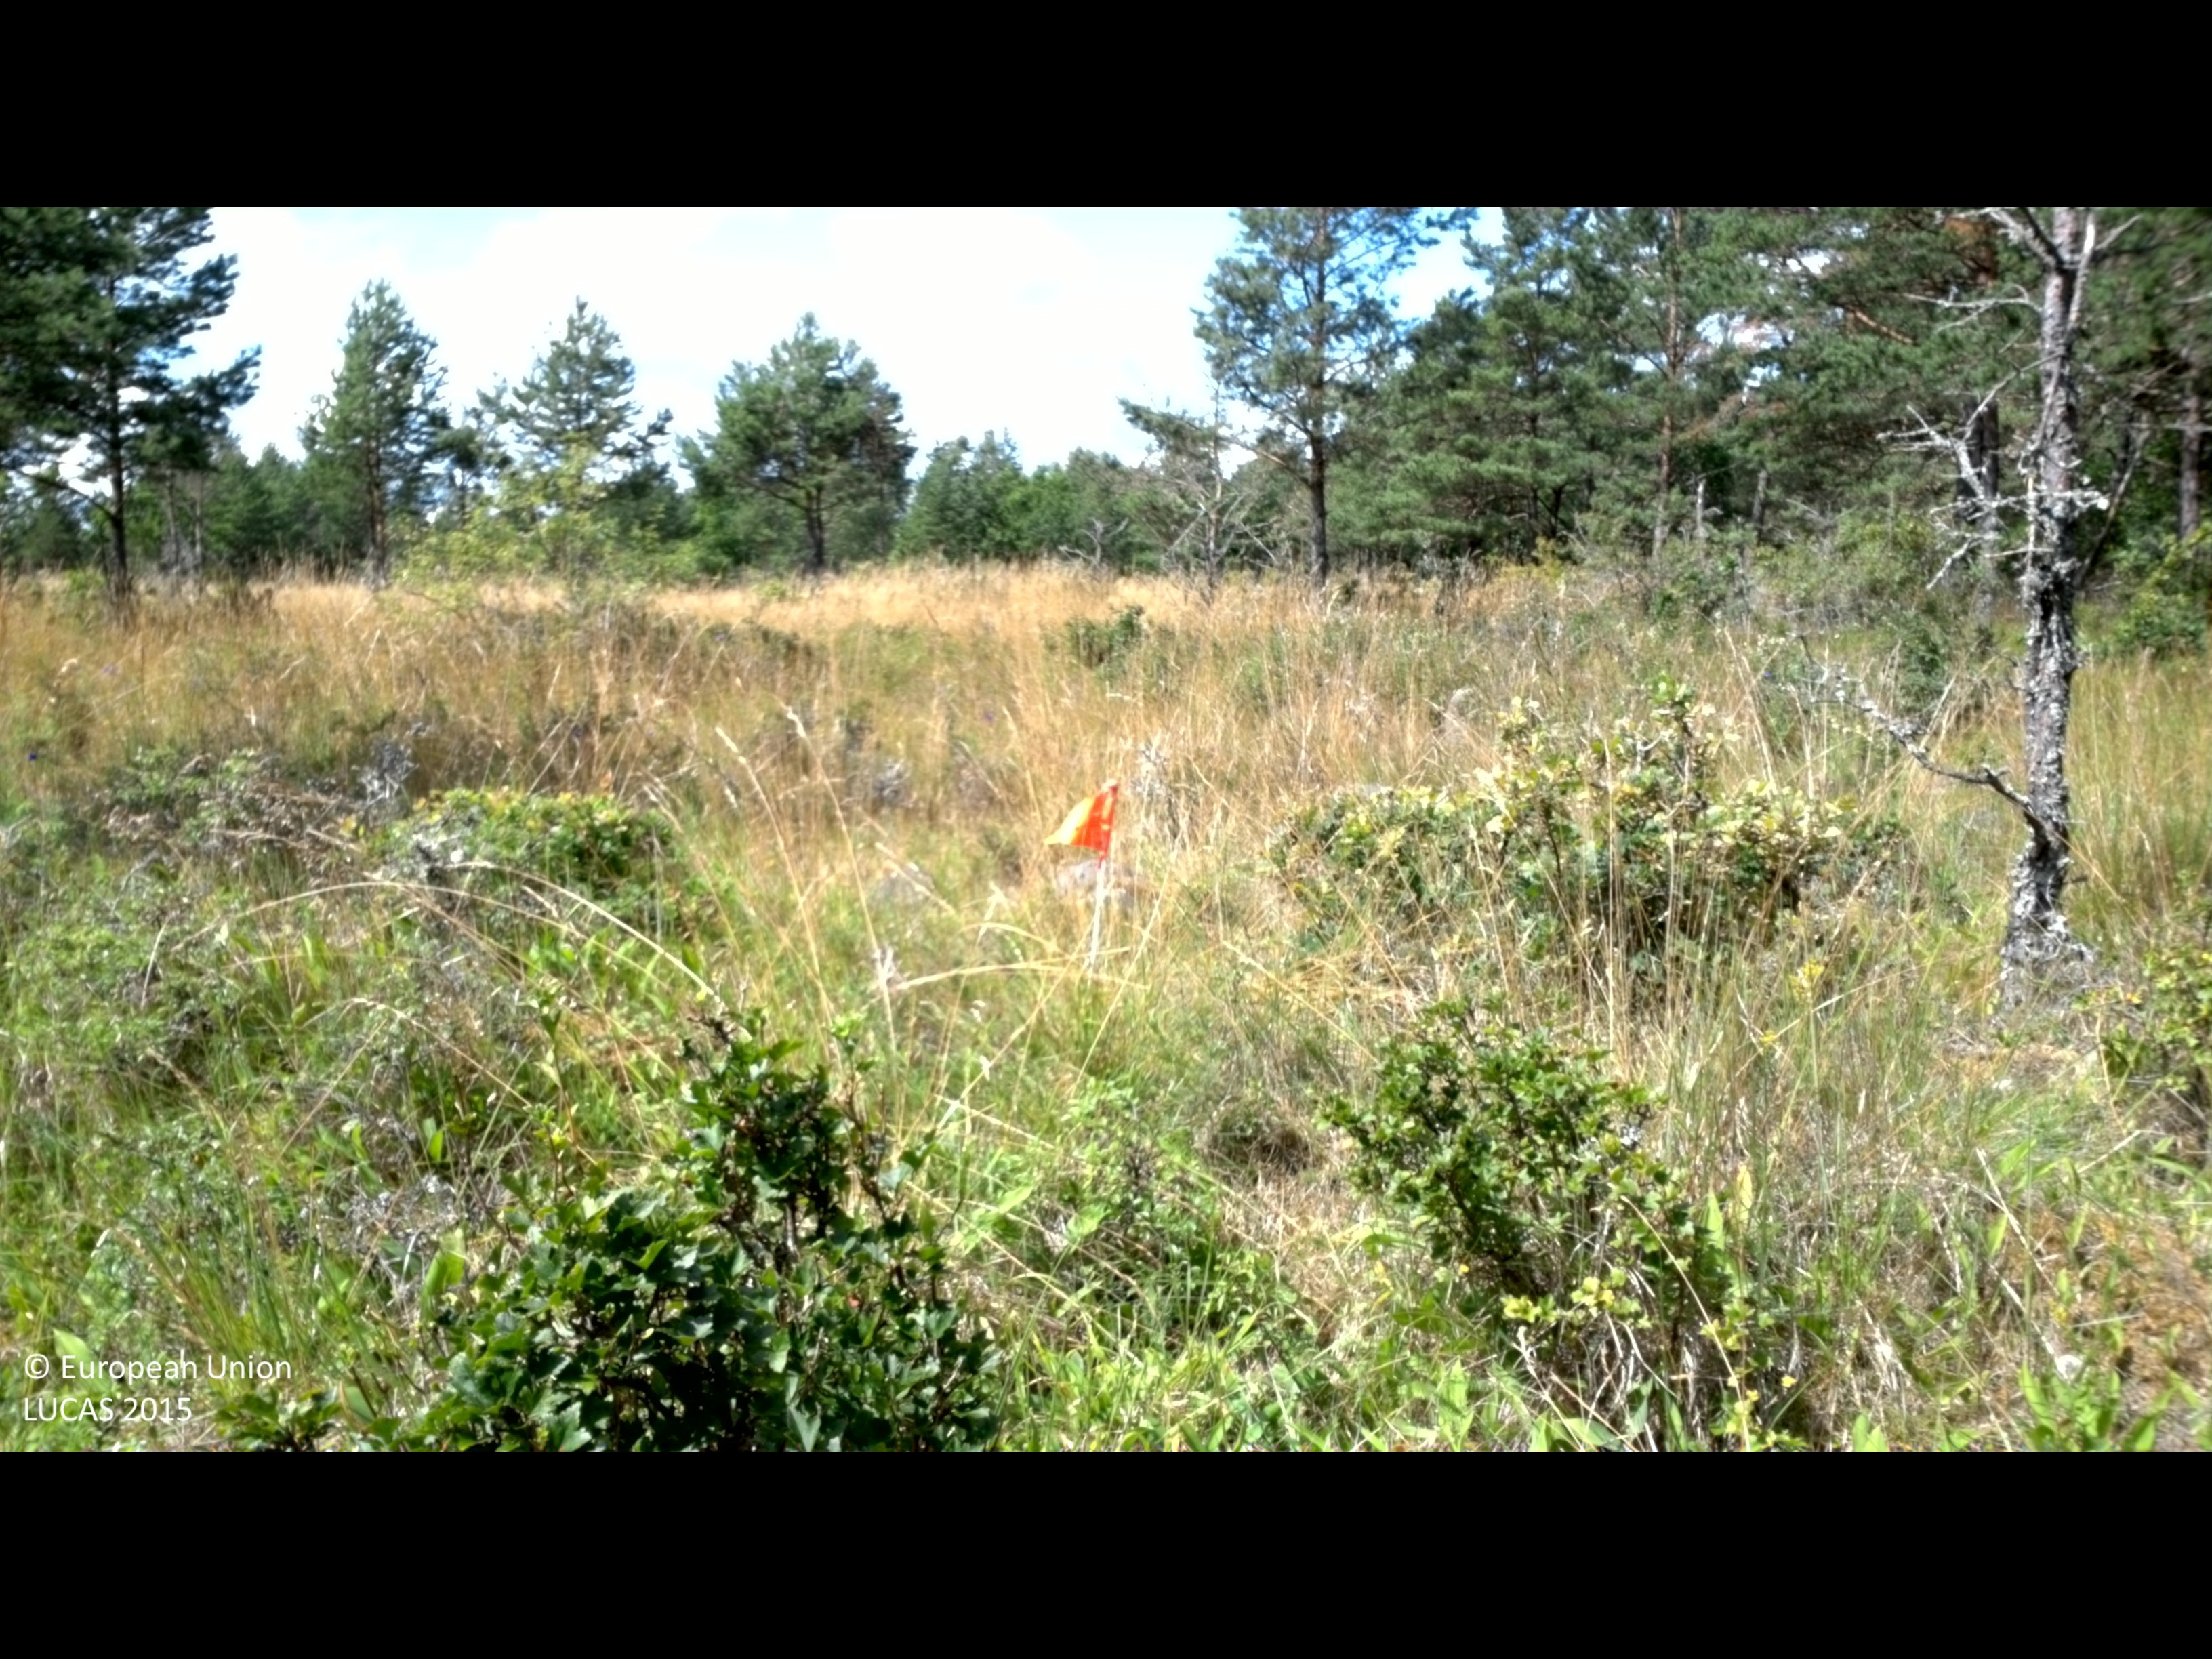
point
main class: Shrubland
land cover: Shrubland with sparse tree cover
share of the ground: 10 - 25 %
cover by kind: herbaceous plants 75 %, shrubs 20 %, coniferous forest trees 5 %
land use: Amenities, museums, leisure
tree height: < 5 m
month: July
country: SE
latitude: 57.3473
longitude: 17.0642
